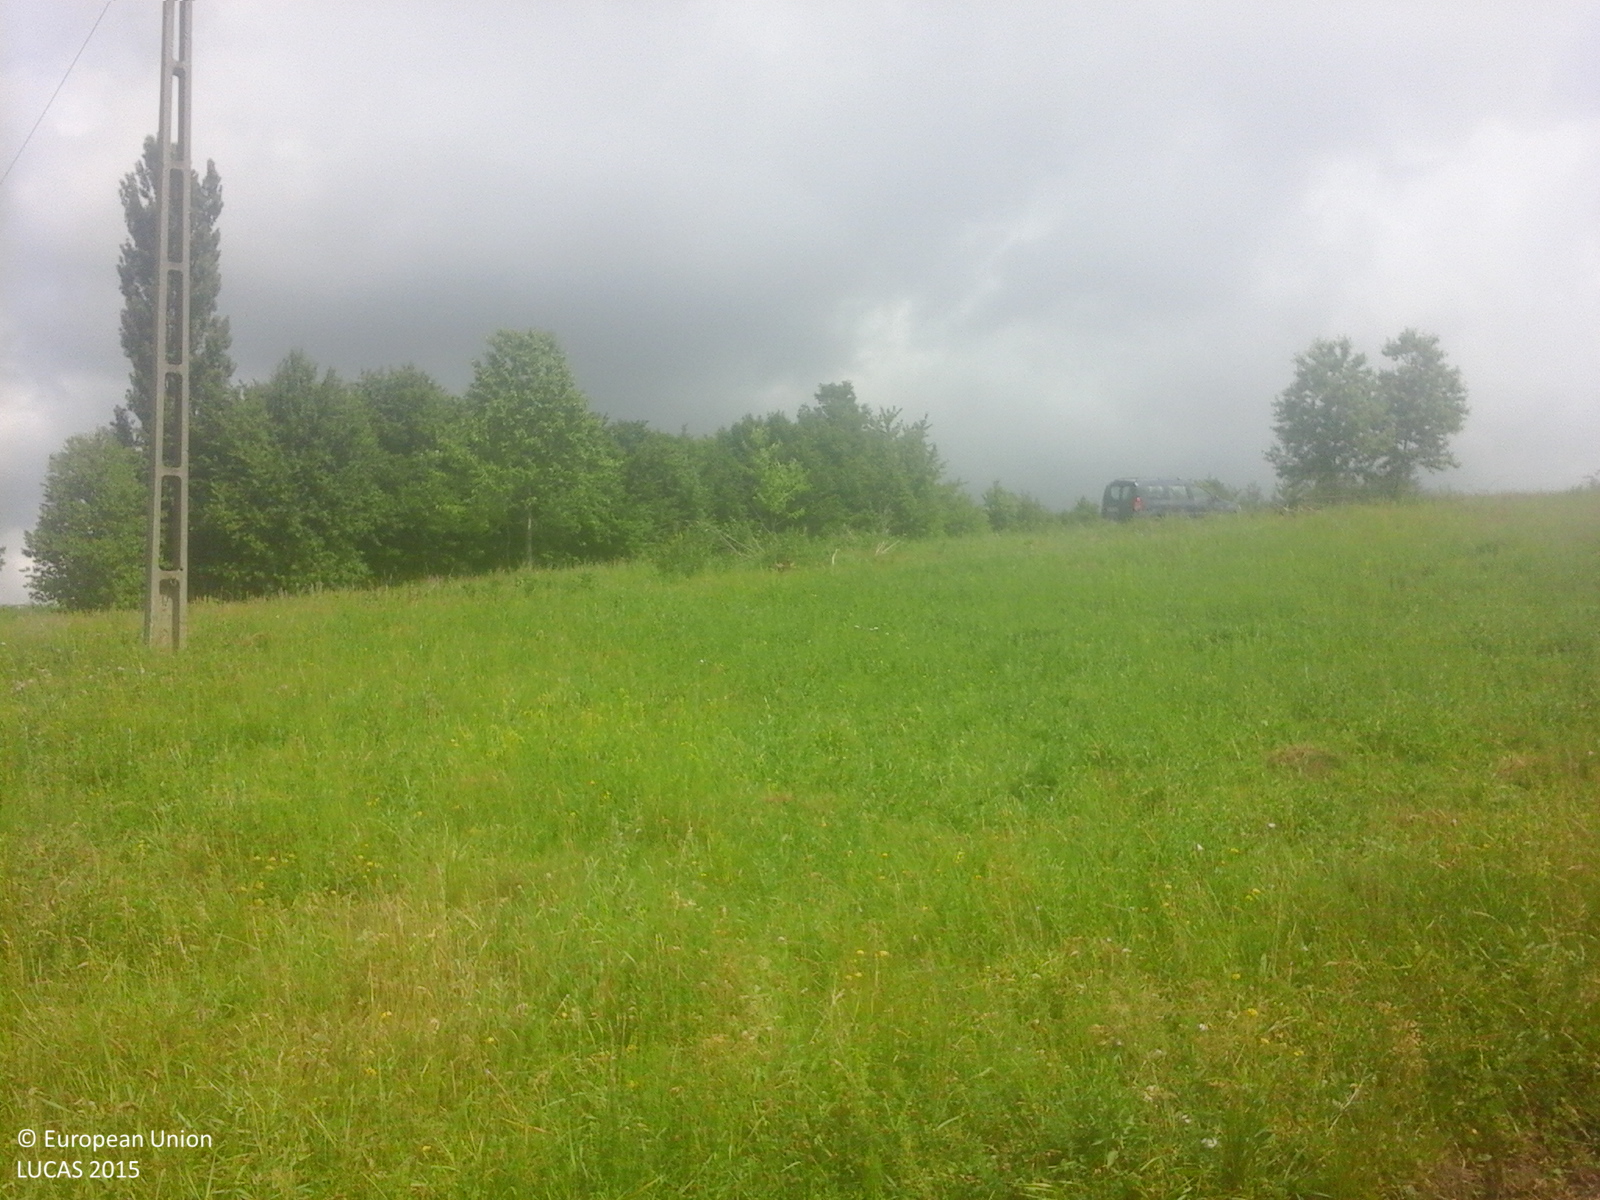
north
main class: Cropland
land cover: Dry pulses
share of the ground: < 10 %
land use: Kitchen garden
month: June
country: RO
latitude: 47.0448
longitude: 26.3637
